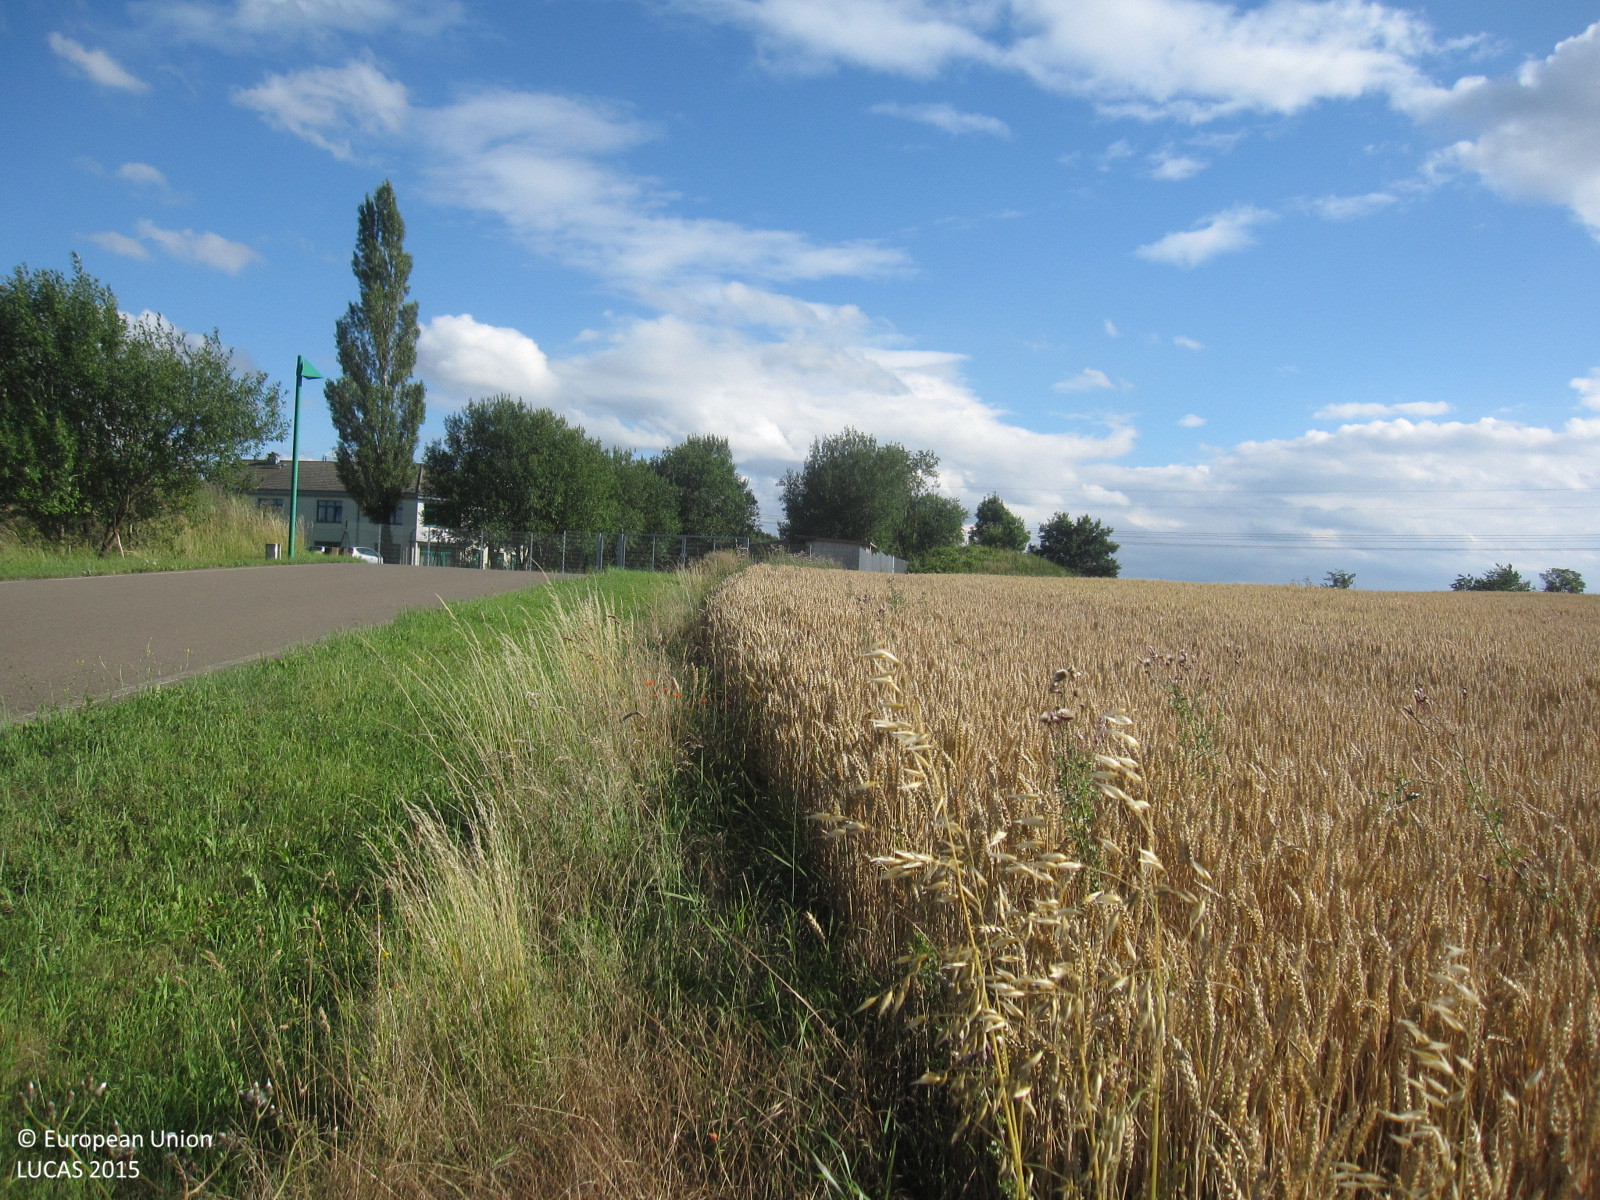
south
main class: Cropland
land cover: Common wheat
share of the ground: > 75 %
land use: Agriculture (excluding fallow land and kitchen gardens)
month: July
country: DE
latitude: 50.9380
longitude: 12.1201
